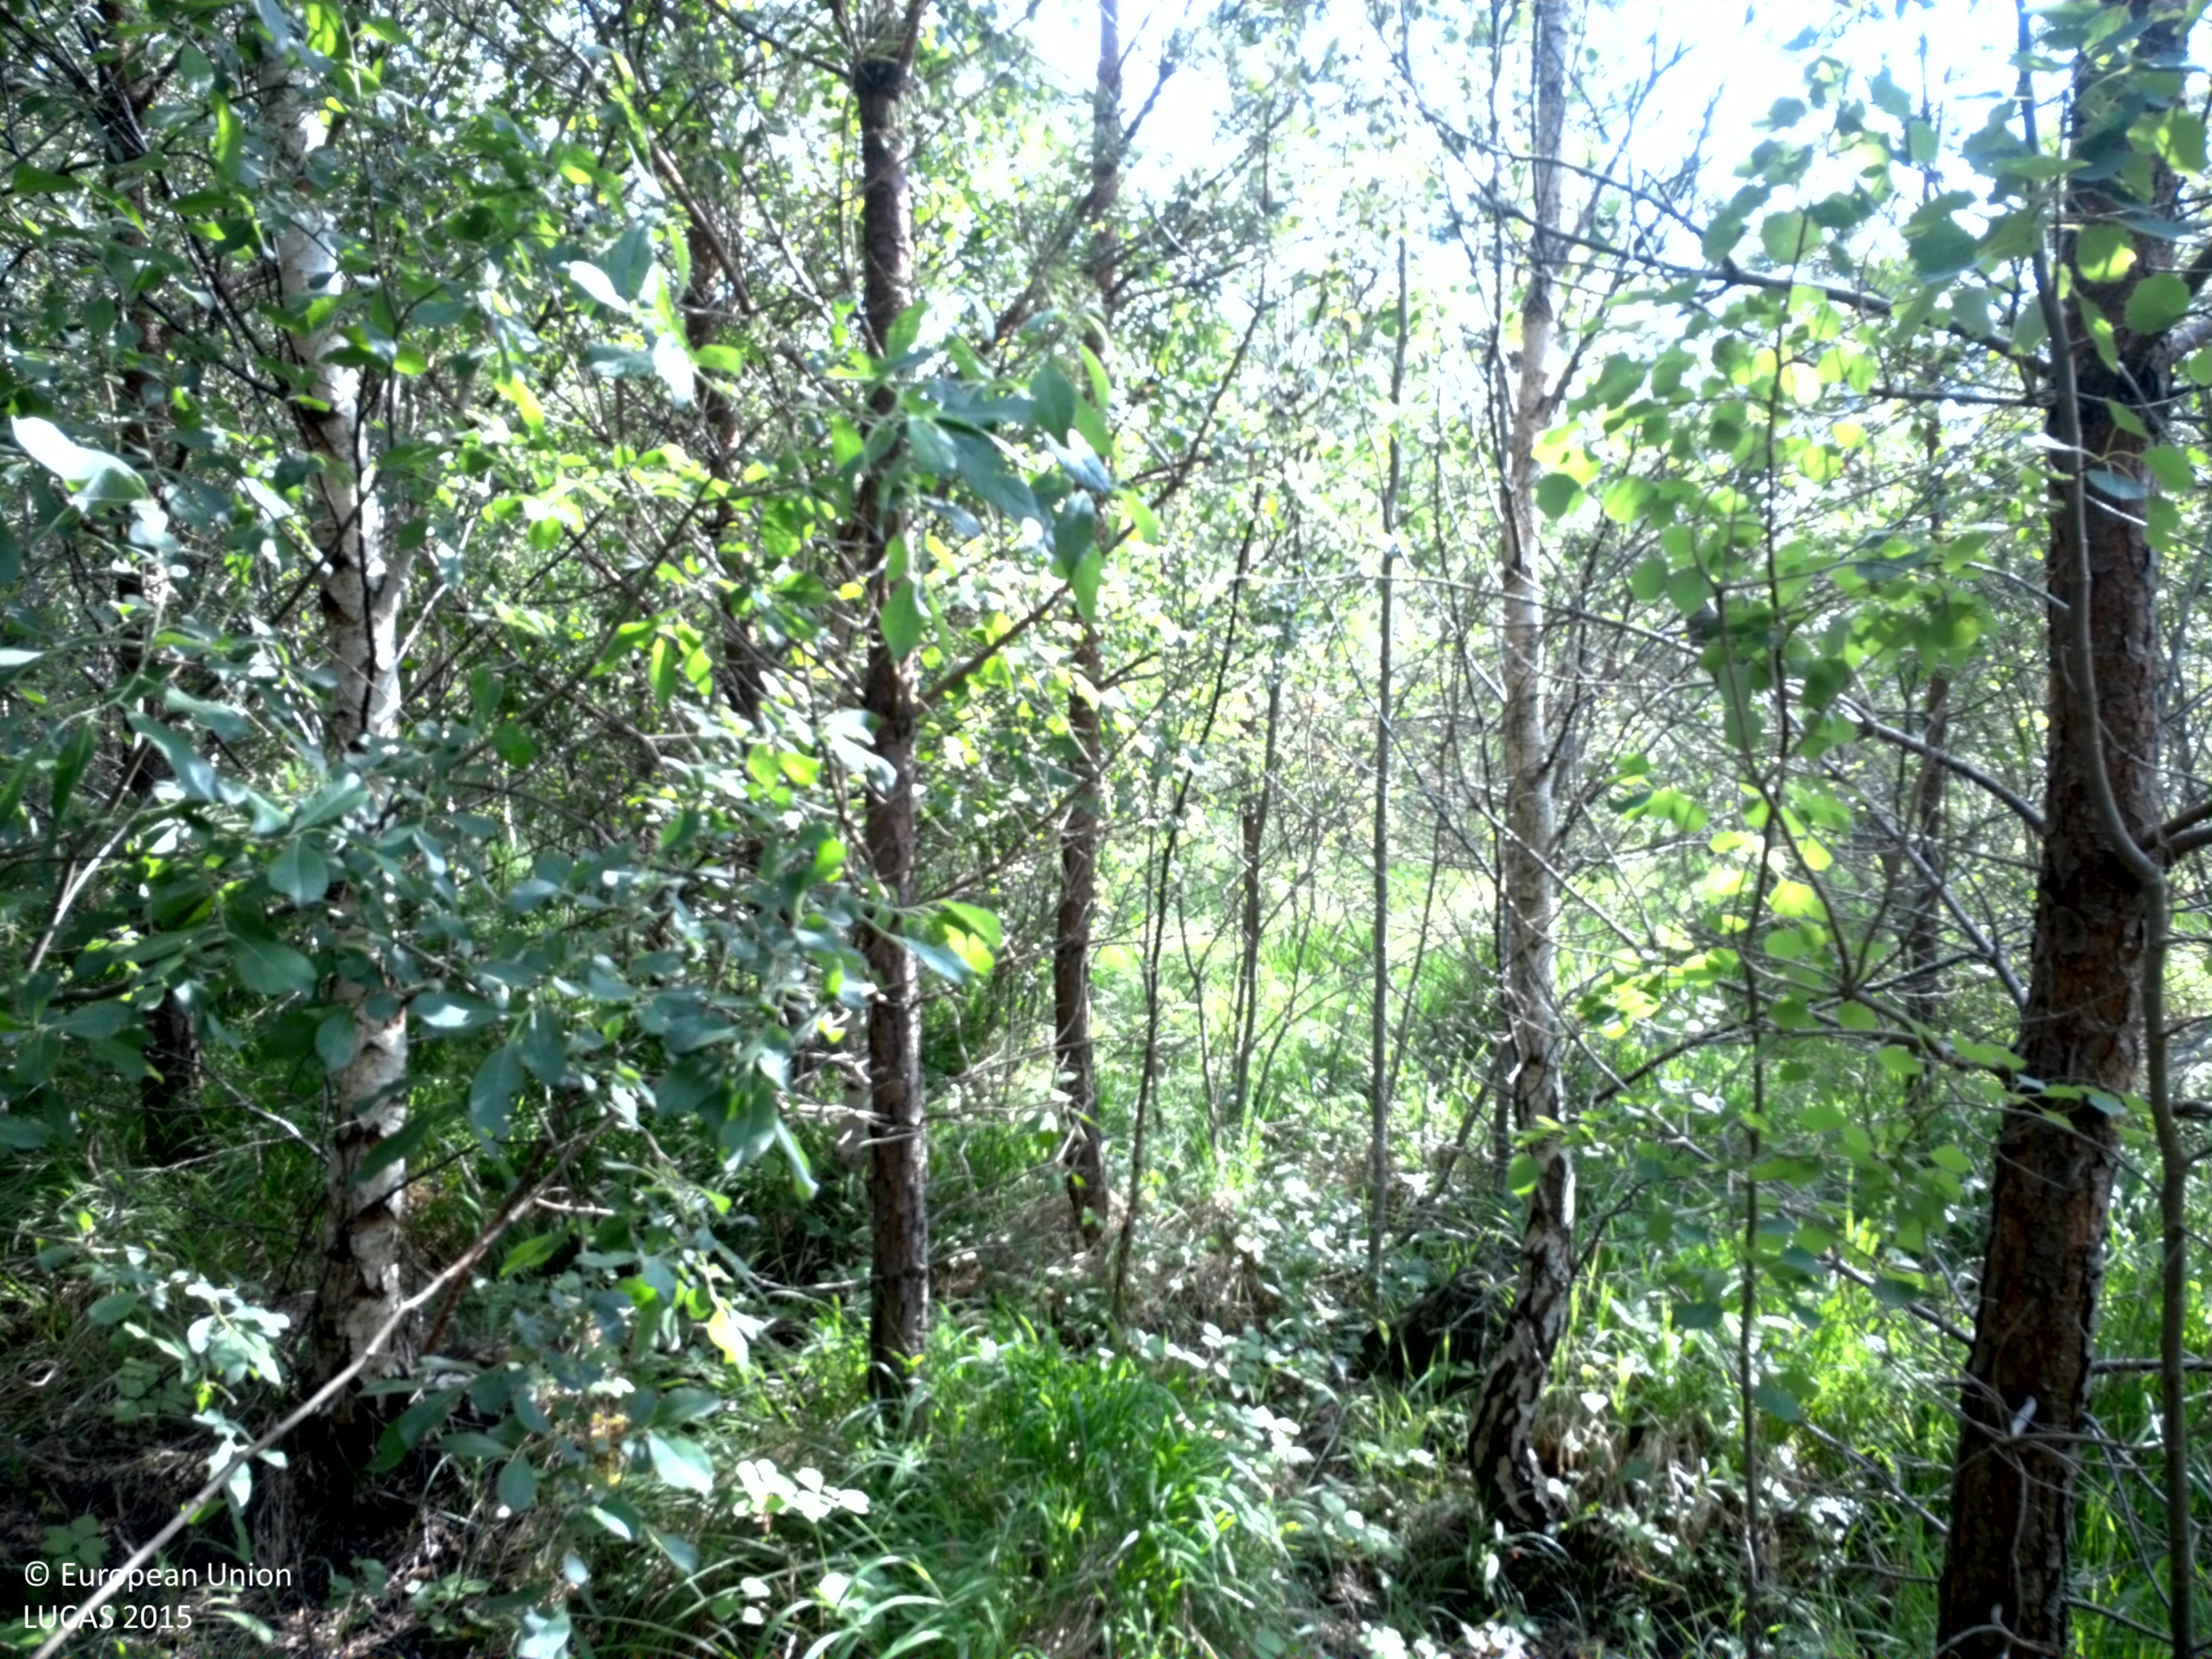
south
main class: Woodland
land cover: Pine dominated mixed woodland
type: hemiboreal forest and nemoral coniferous forest and mixed broadleaved-coniferous forest
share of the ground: > 75 %
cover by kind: coniferous forest trees 55 %, broadleaved forest trees 25 %, herbaceous plants 20 %
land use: Forestry
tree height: < 5 m
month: July
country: SE
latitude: 57.4288
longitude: 18.7209
